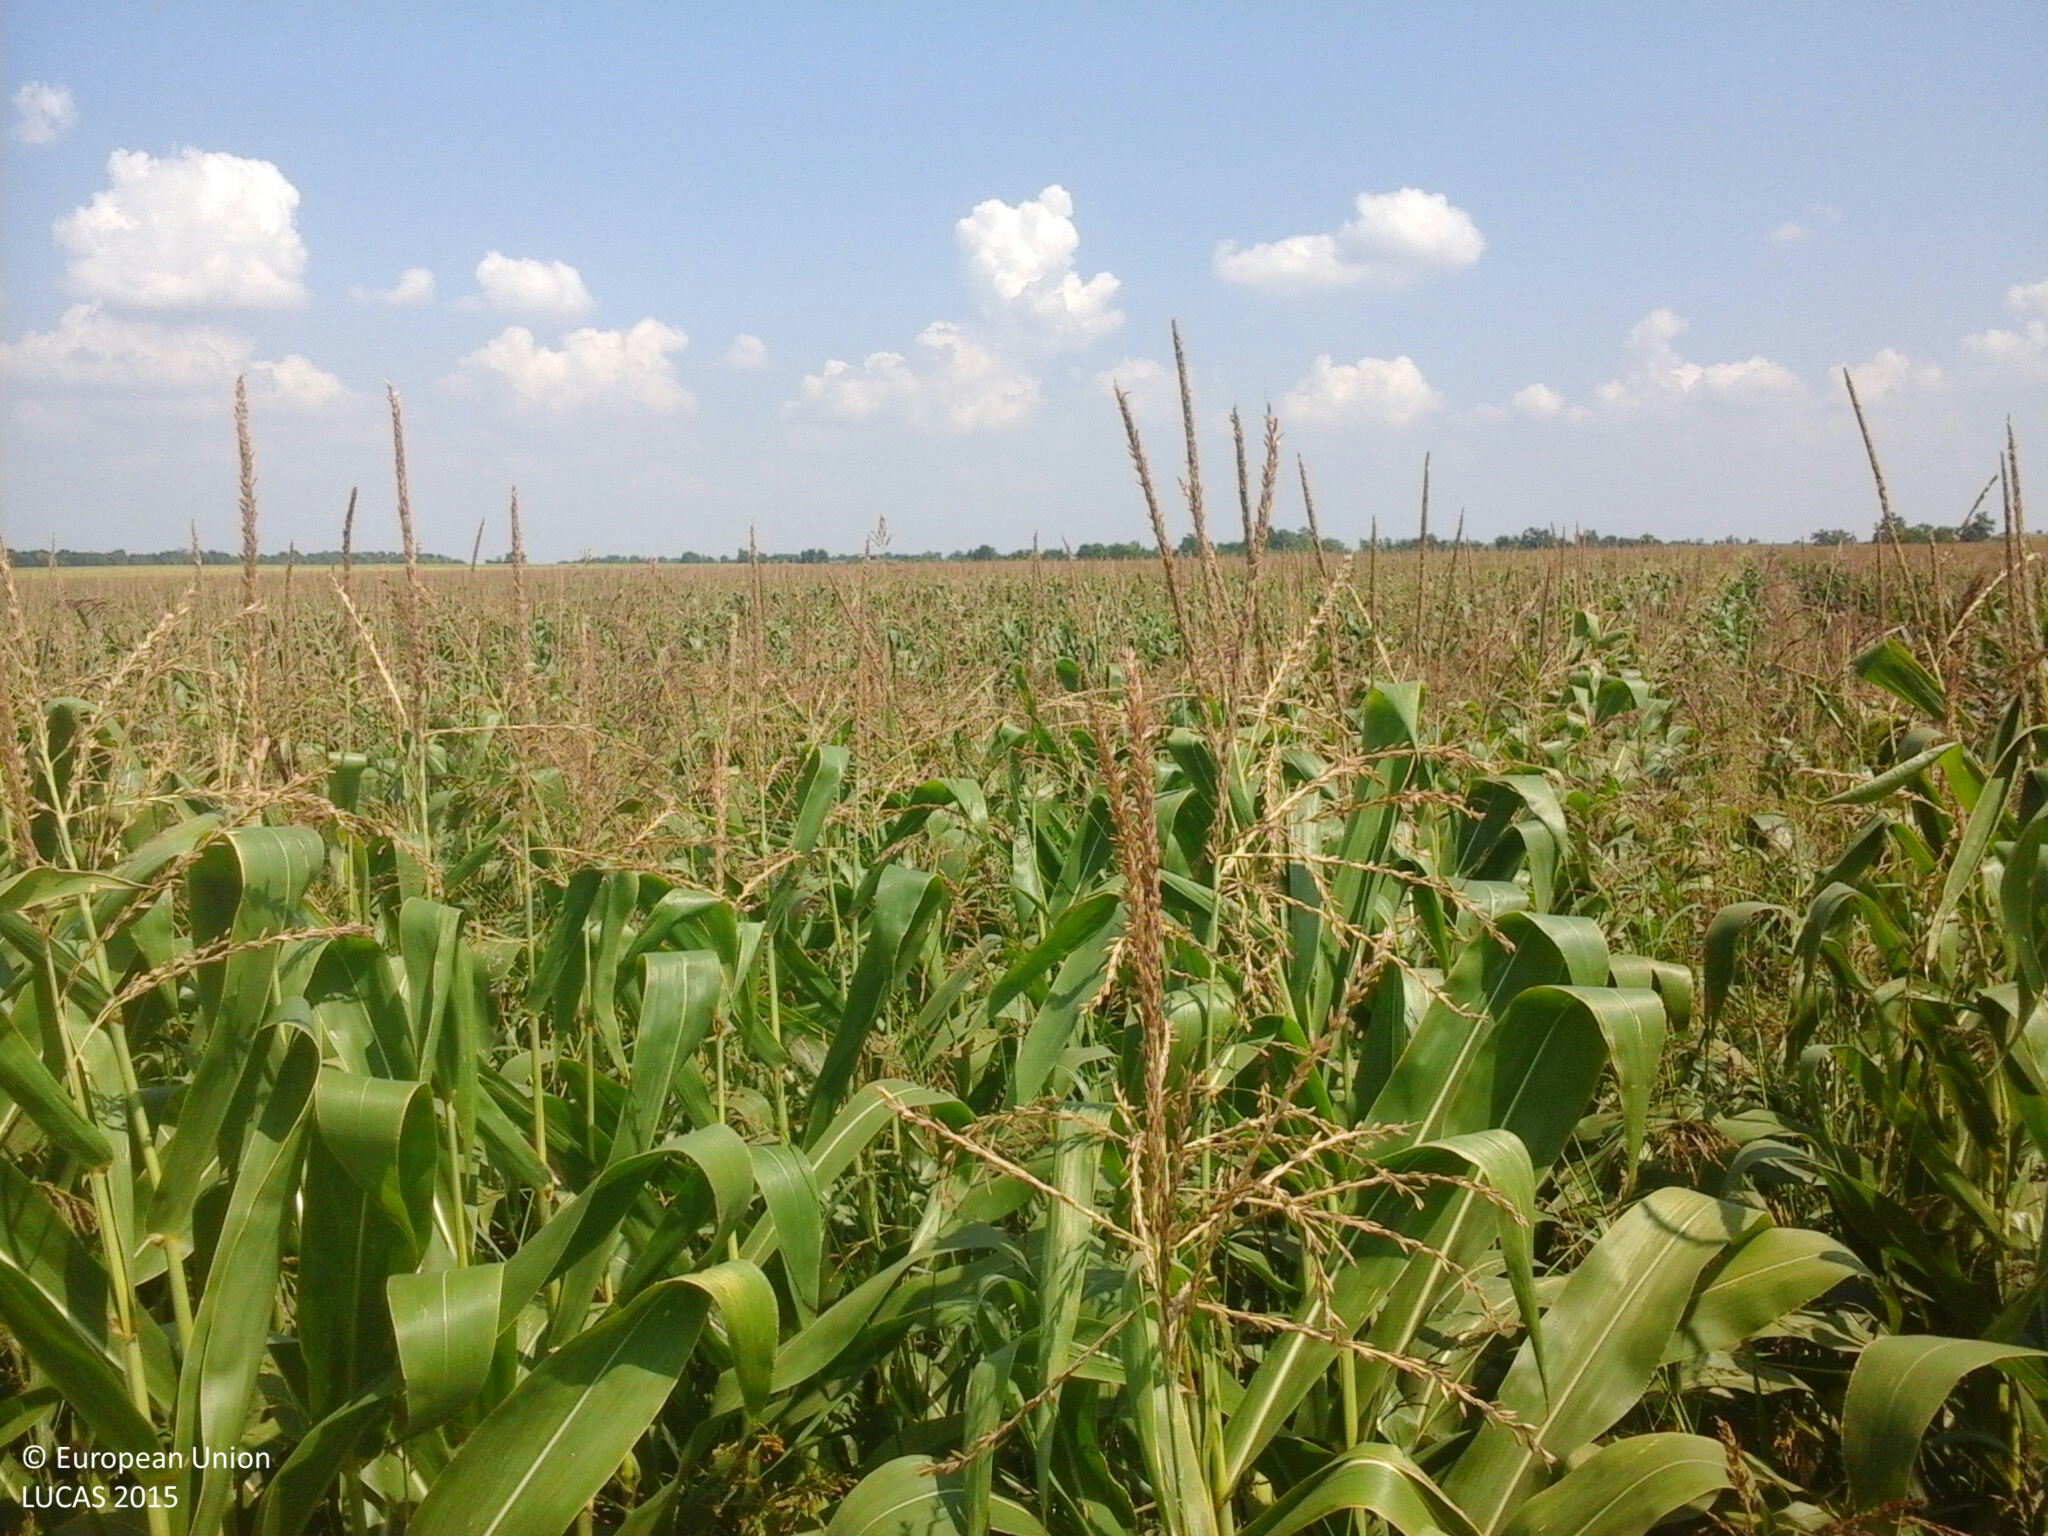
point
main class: Cropland
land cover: Maize
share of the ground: > 75 %
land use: Agriculture (excluding fallow land and kitchen gardens)
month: August
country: HU
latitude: 46.9032
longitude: 18.4525
